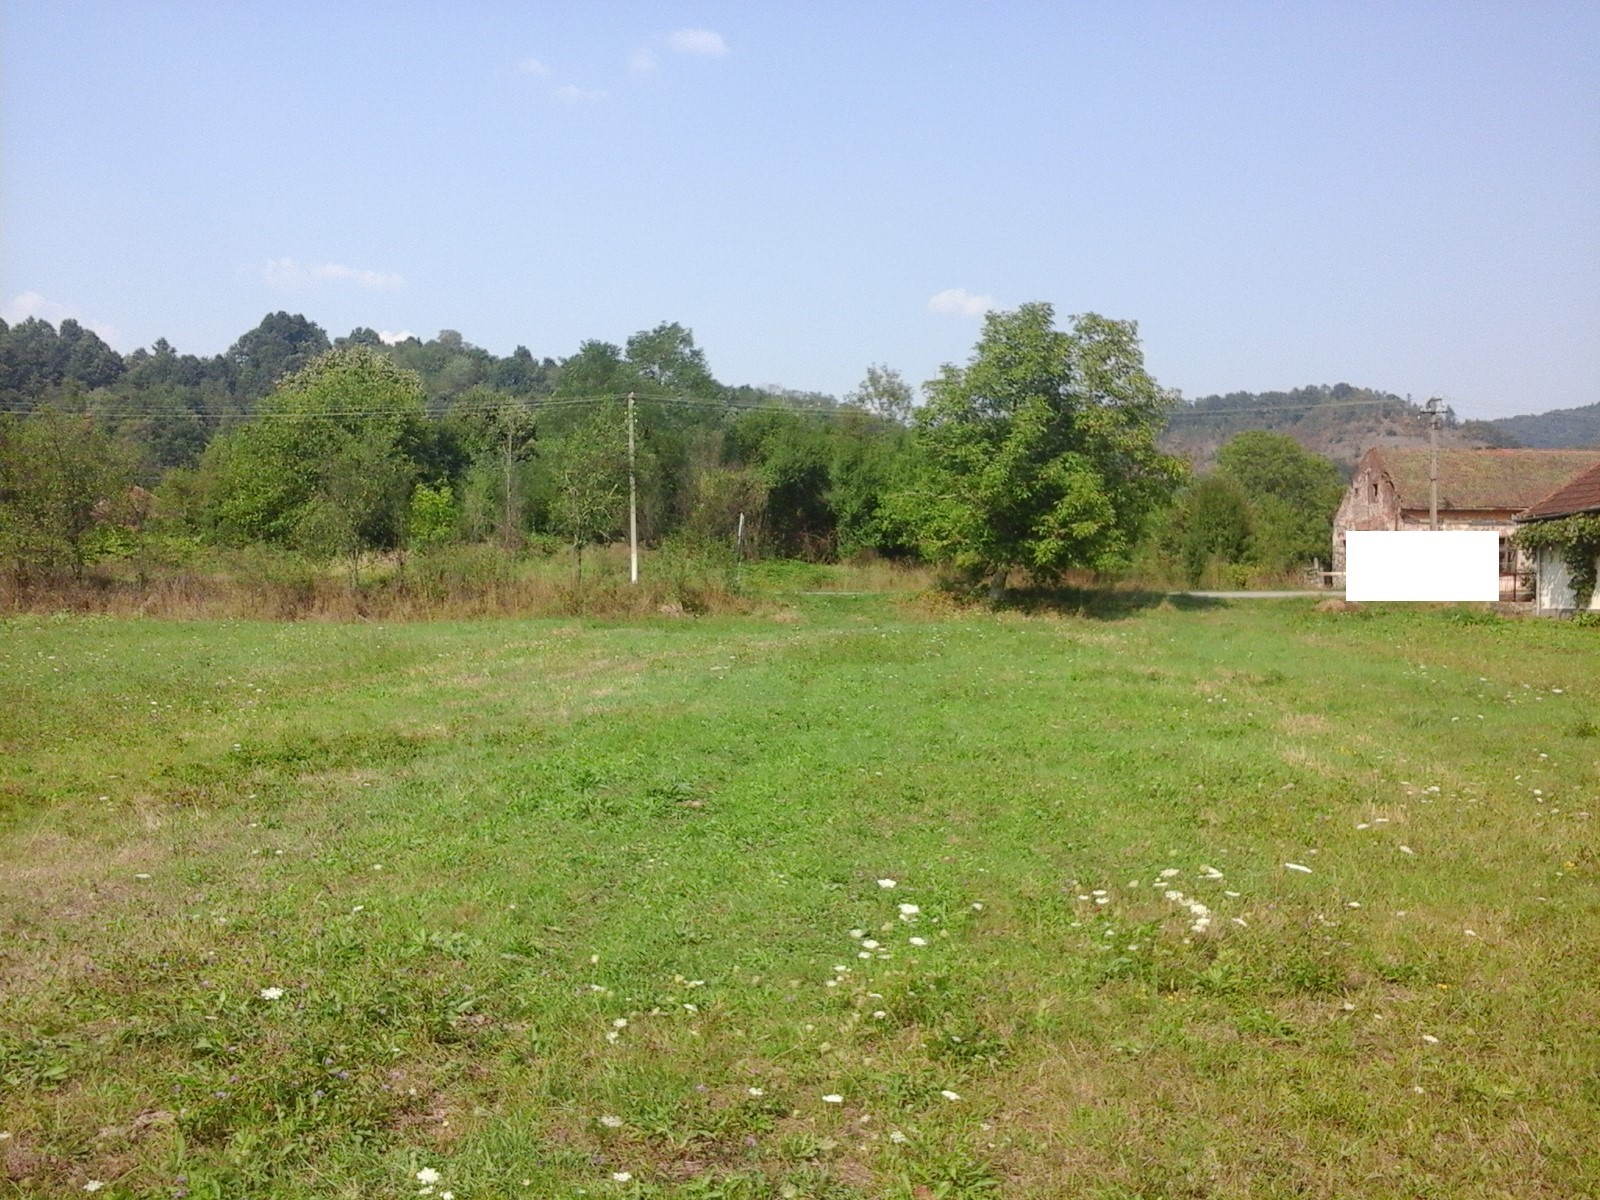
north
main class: Grassland
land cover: Grassland without tree/shrub cover
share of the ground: > 75 %
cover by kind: herbaceous plants 100 %
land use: Agriculture (excluding fallow land and kitchen gardens)
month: August
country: RO
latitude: 46.2979
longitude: 22.4212
